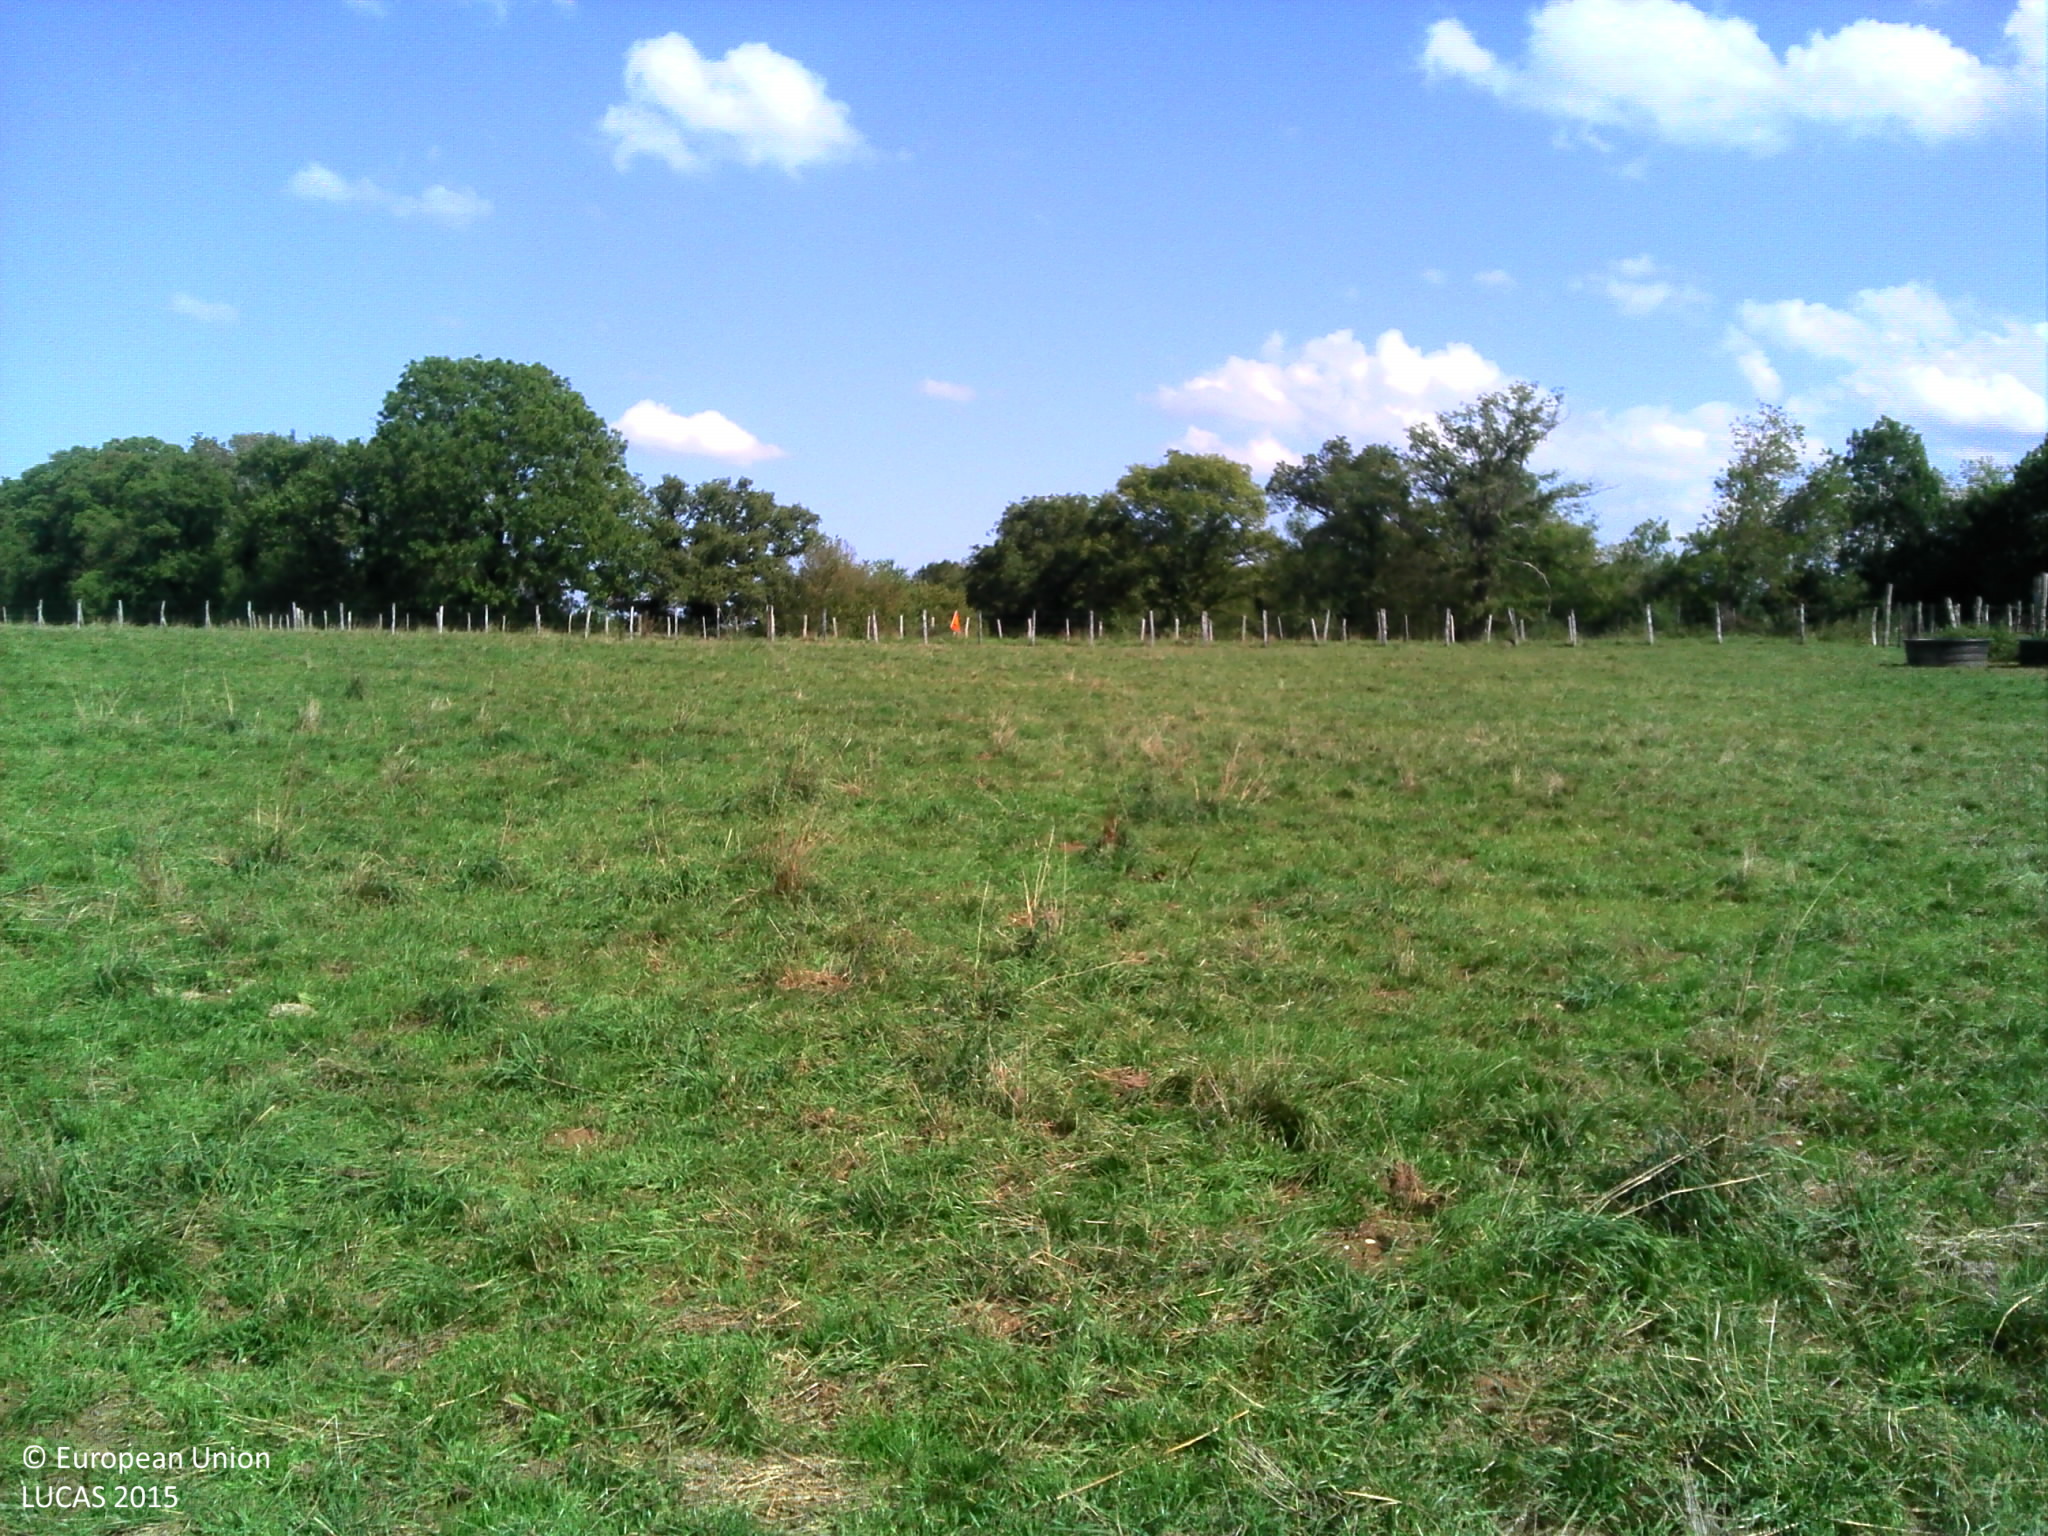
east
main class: Grassland
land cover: Grassland without tree/shrub cover
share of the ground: > 75 %
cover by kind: herbaceous plants 100 %
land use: Agriculture (excluding fallow land and kitchen gardens)
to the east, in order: Grassland without tree/shrub cover; Fences; Grass margins; Paved roads, cycling and walking lanes; Grass margins; Ditches and canals; Fences; Grassland without tree/shrub cover; Broadleaved woodland; Grassland without tree/shrub cover; Broadleaved woodland; Grassland without tree/shrub cover; Spontaneously vegetated surfaces
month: September
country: FR
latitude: 47.2225
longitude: 6.2382
